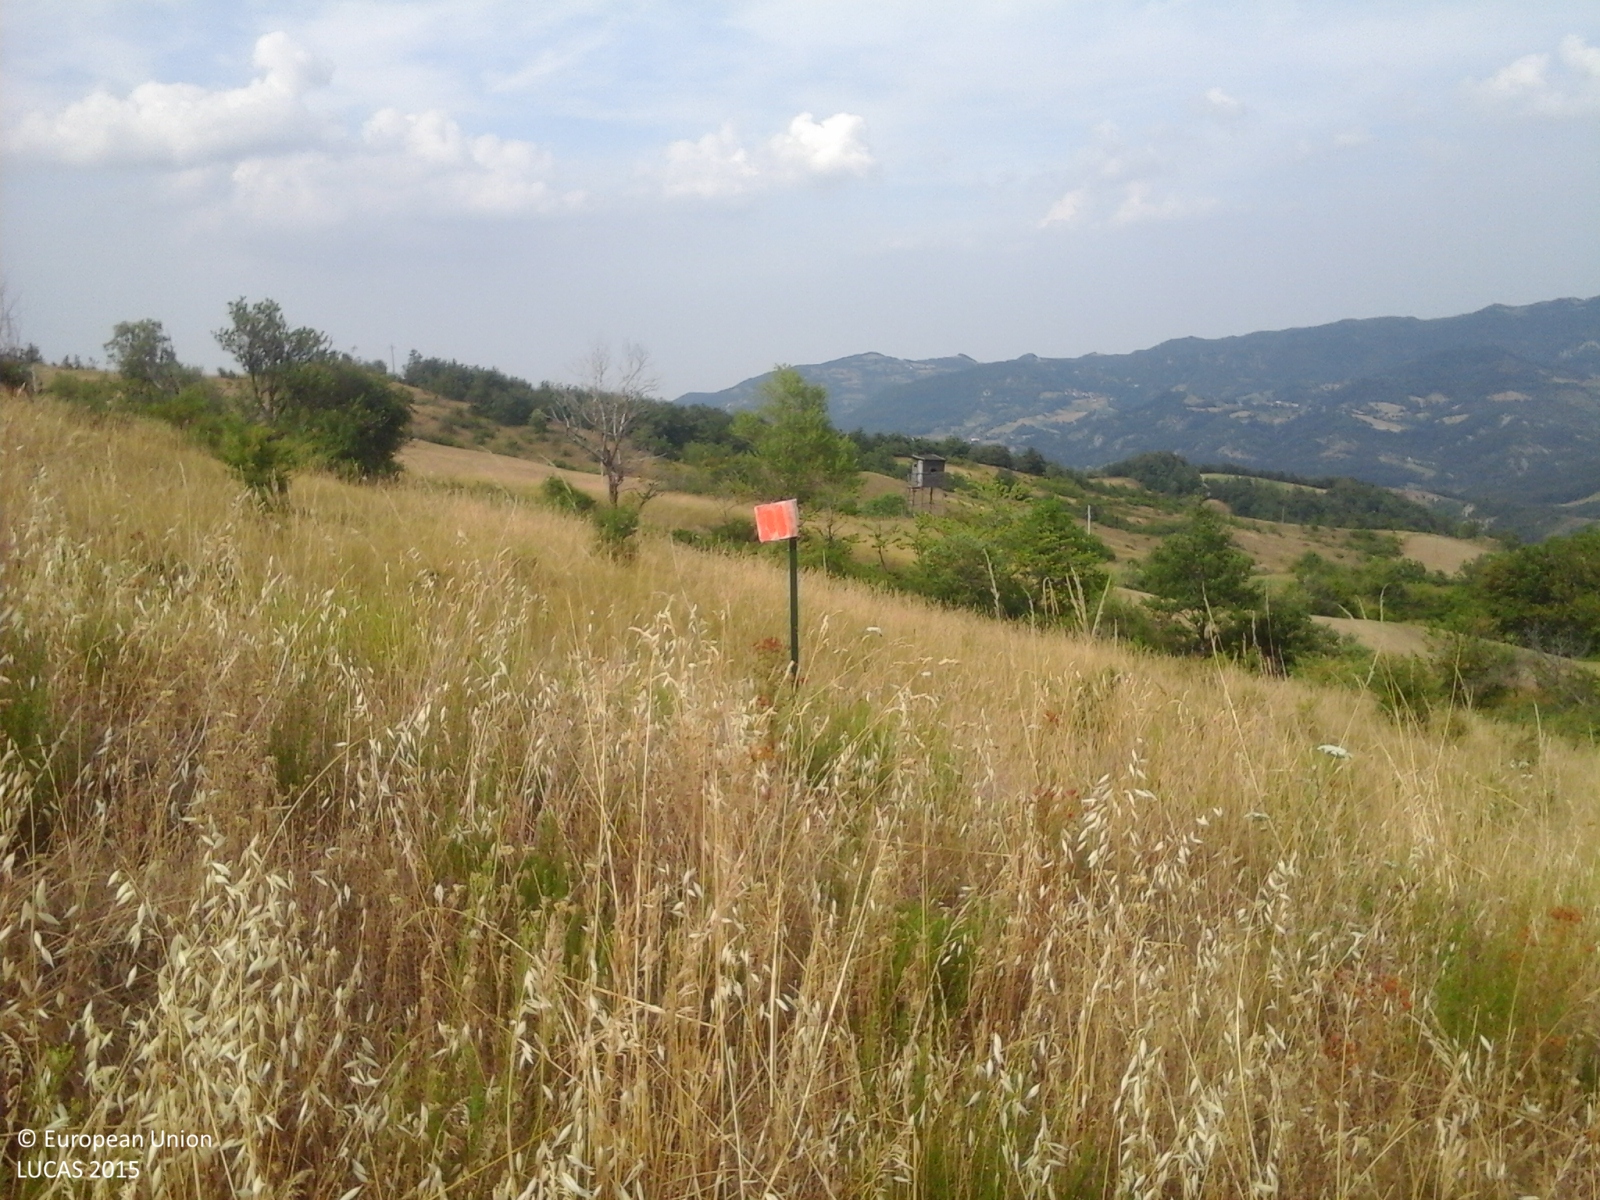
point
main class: Grassland
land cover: Grassland with sparse tree/shrub cover
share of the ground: > 75 %
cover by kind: herbaceous plants 90 %, broadleaved forest trees 5 %, shrubs 5 %
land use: Agriculture (excluding fallow land and kitchen gardens)
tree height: < 5 m
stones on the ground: 10 - 25 %
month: July
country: IT
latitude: 44.4403
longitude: 10.2883
